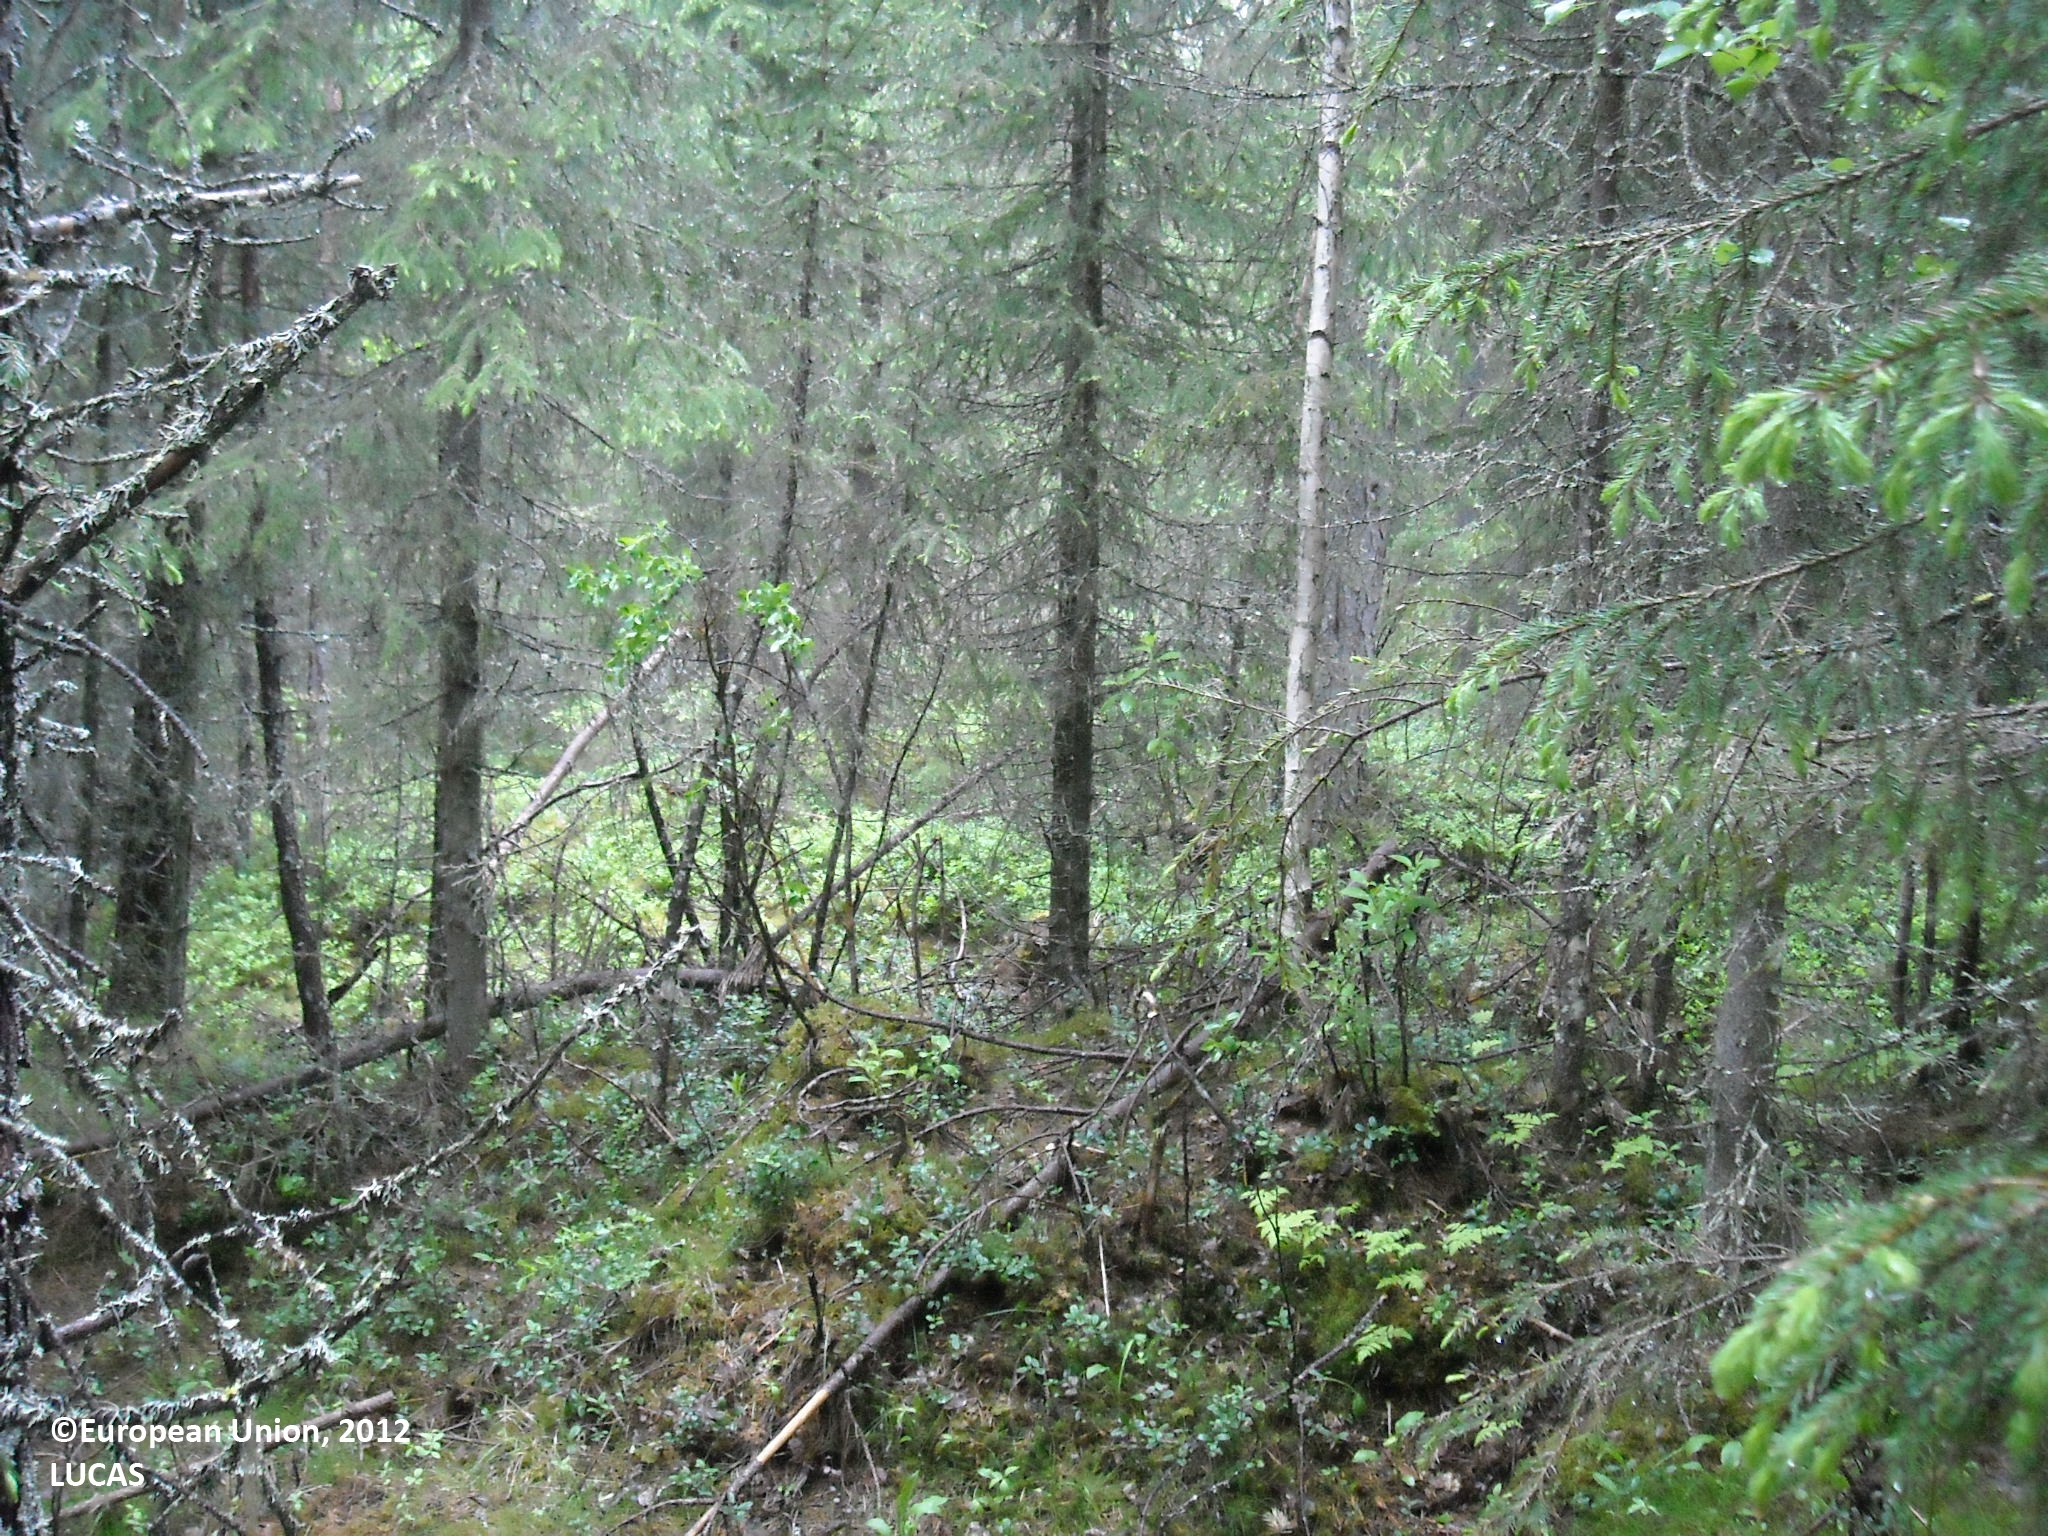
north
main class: Woodland
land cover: Other mixed woodland
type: boreal forest
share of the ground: > 75 %
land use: Forestry
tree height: > 5 m
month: June
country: FI
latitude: 65.4728
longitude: 27.9100
